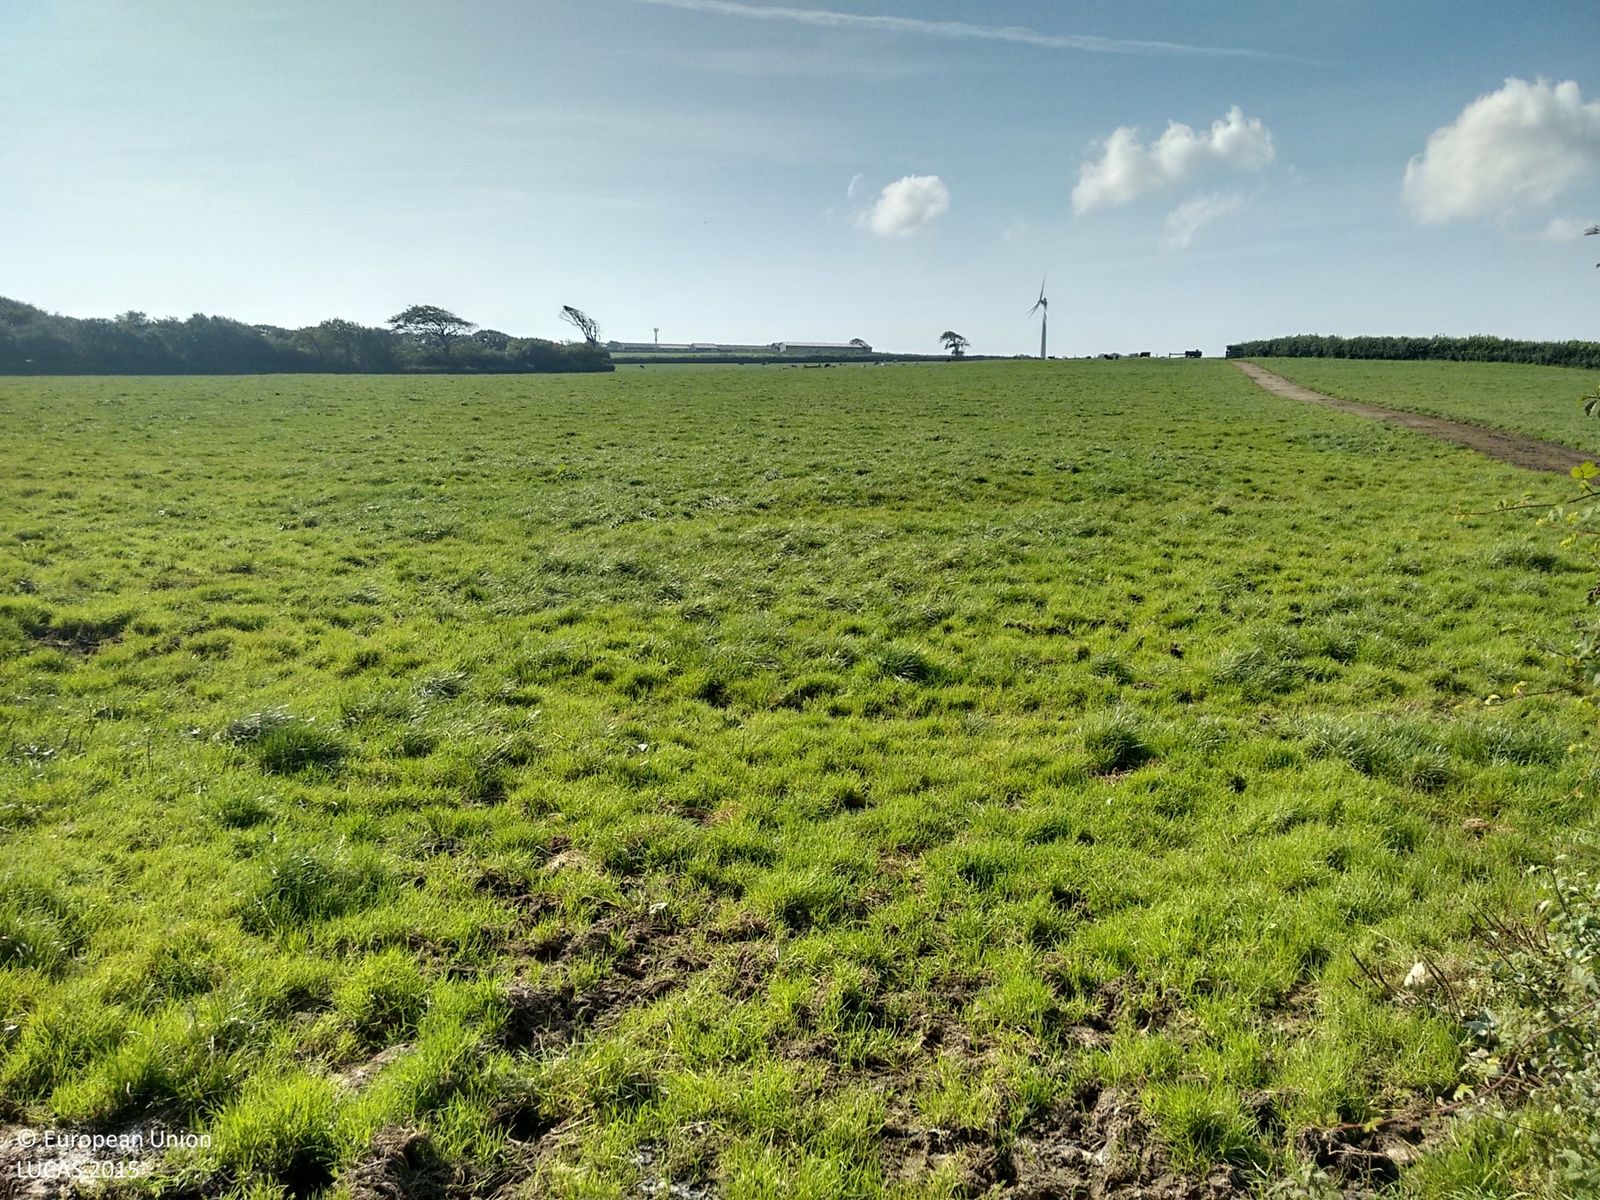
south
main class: Grassland
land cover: Grassland without tree/shrub cover
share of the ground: > 75 %
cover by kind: herbaceous plants 100 %
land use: Agriculture (excluding fallow land and kitchen gardens)
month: September
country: GB
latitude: 50.8351
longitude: -4.4014
